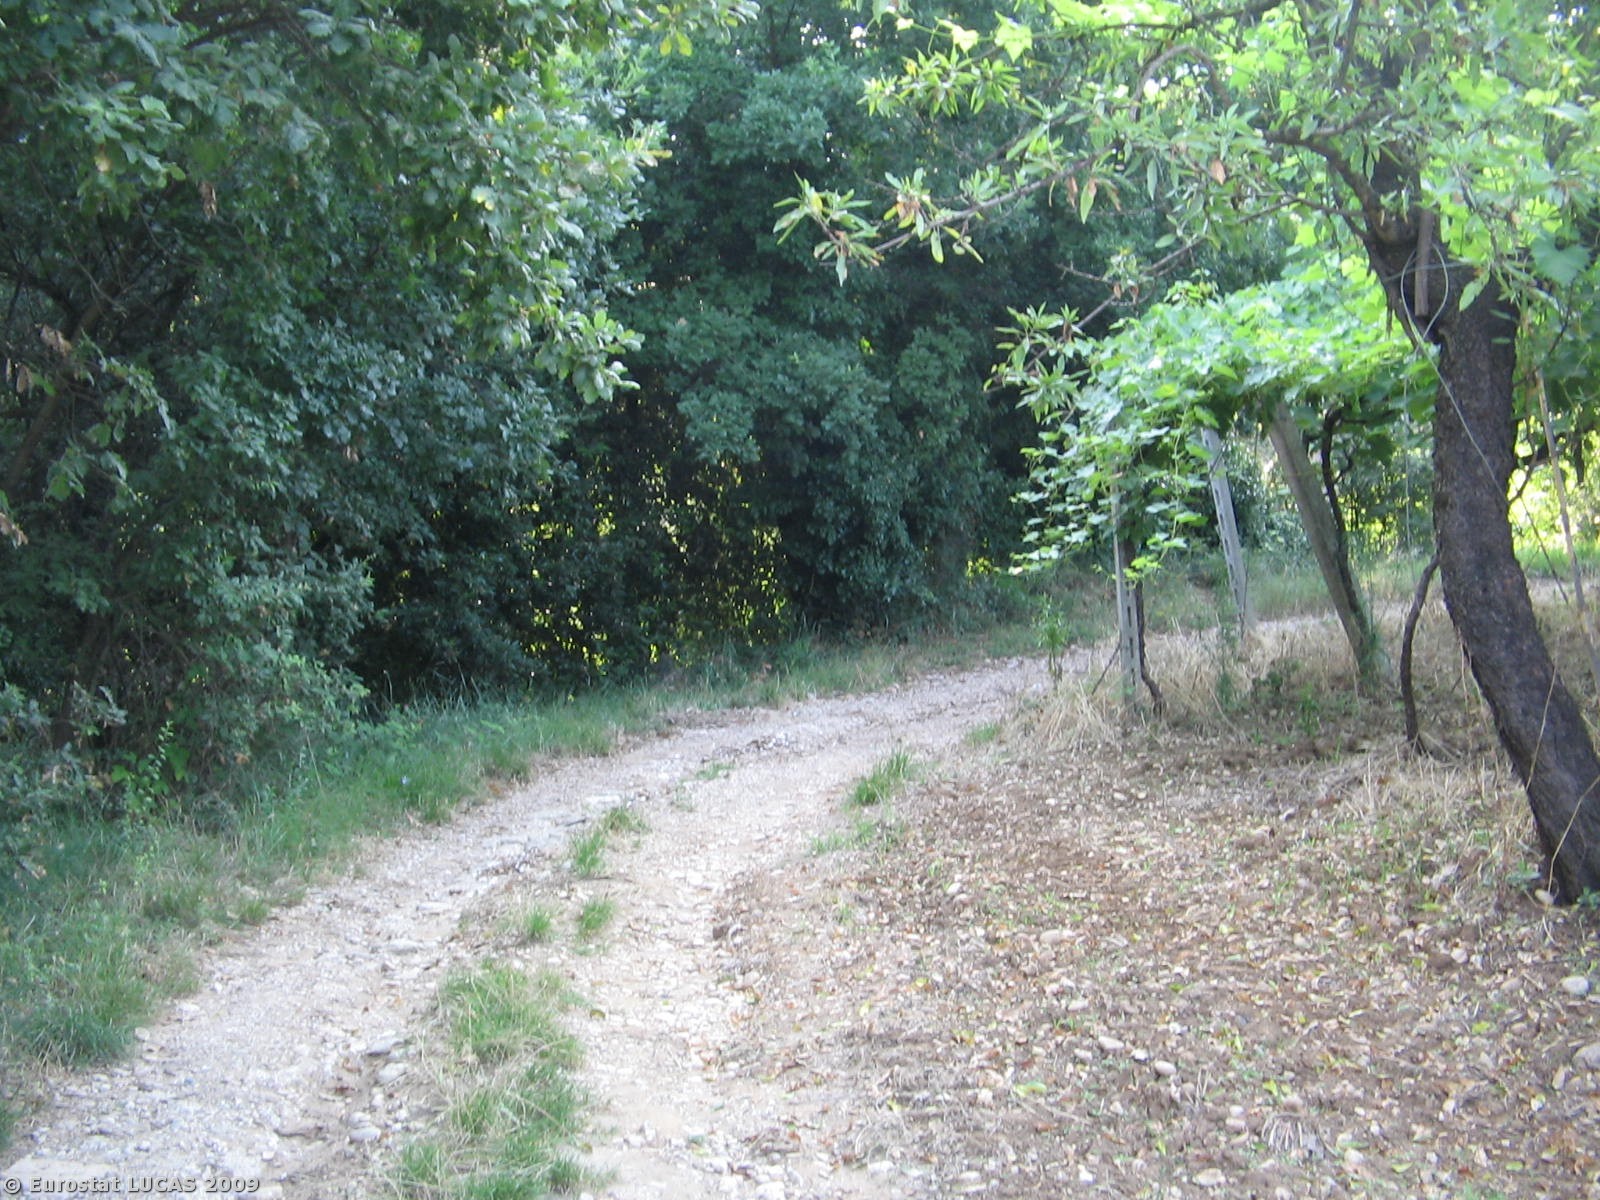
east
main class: Woodland
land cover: Broadleaved woodland
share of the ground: > 75 %
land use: Forestry
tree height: < 5 m
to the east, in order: Broadleaved woodland; Vineyards; Grassland with sparse tree/shrub cover; Broadleaved woodland; Grass margins; Paved roads, cycling and walking lanes; Ditches and canals; Grass margins; Vineyards; Grassland with sparse tree/shrub cover; Olive groves; Grassland with sparse tree/shrub cover; Broadleaved woodland
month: July
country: IT
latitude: 42.3046
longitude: 14.4145
